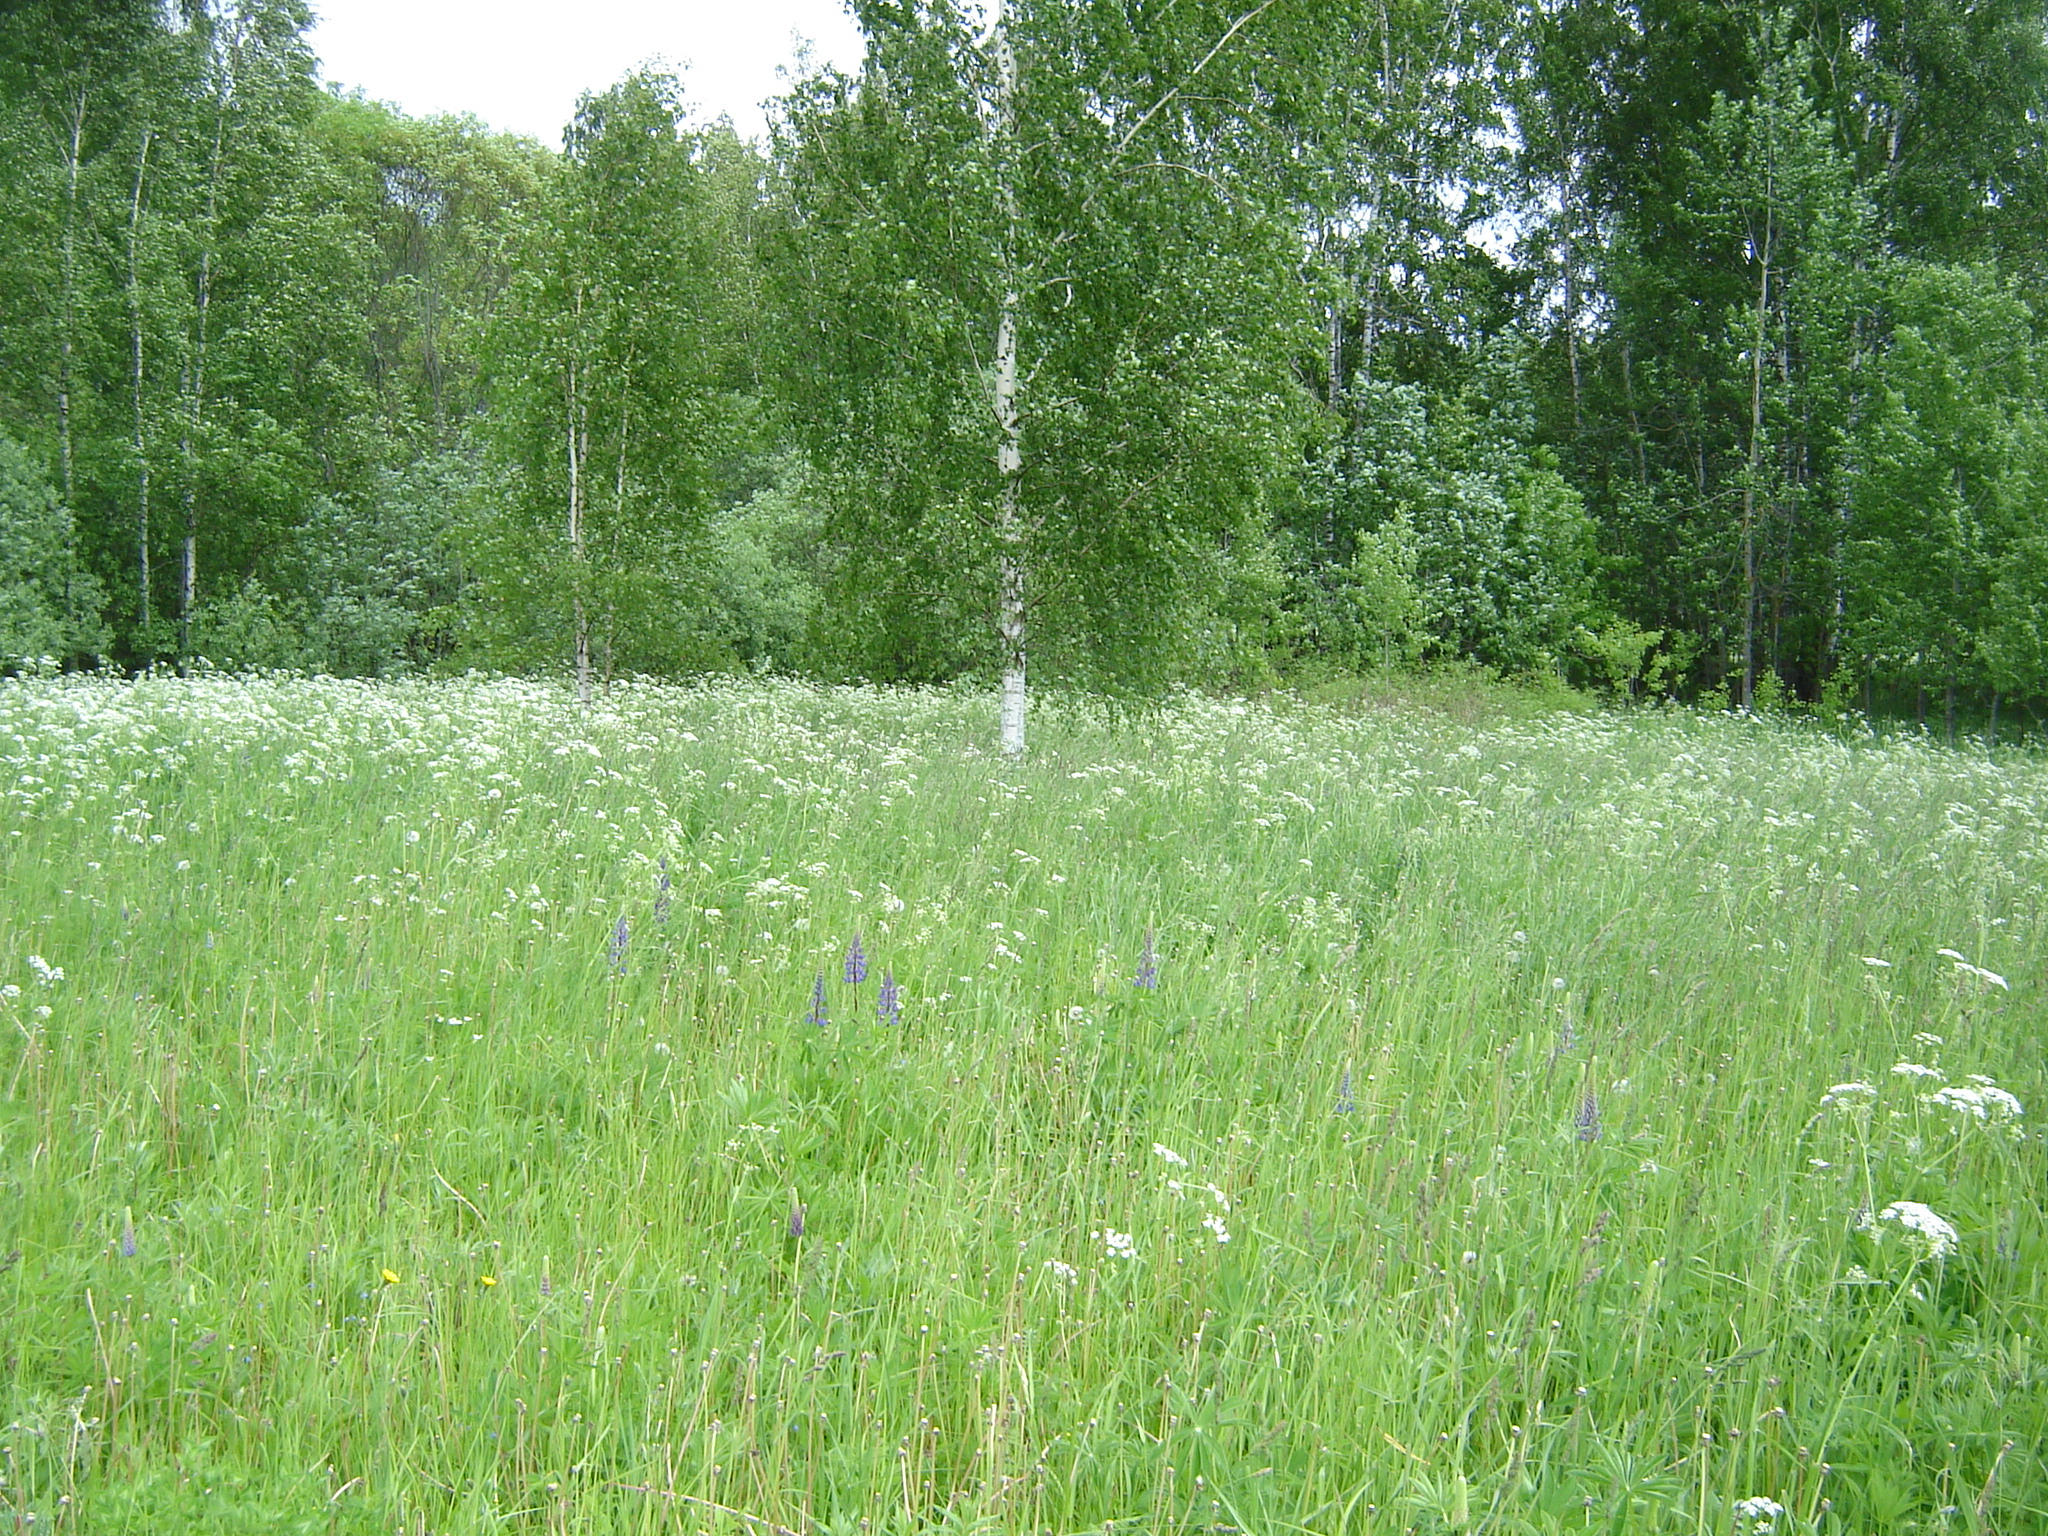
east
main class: Grassland
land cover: Grassland without tree/shrub cover
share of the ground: > 75 %
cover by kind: herbaceous plants 100 %
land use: Agriculture (excluding fallow land and kitchen gardens)
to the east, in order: Grassland without tree/shrub cover; Single bushes/trees; Grassland without tree/shrub cover; Broadleaved woodland; Grassland without tree/shrub cover
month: June
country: LT
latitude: 55.7049
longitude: 25.5777
